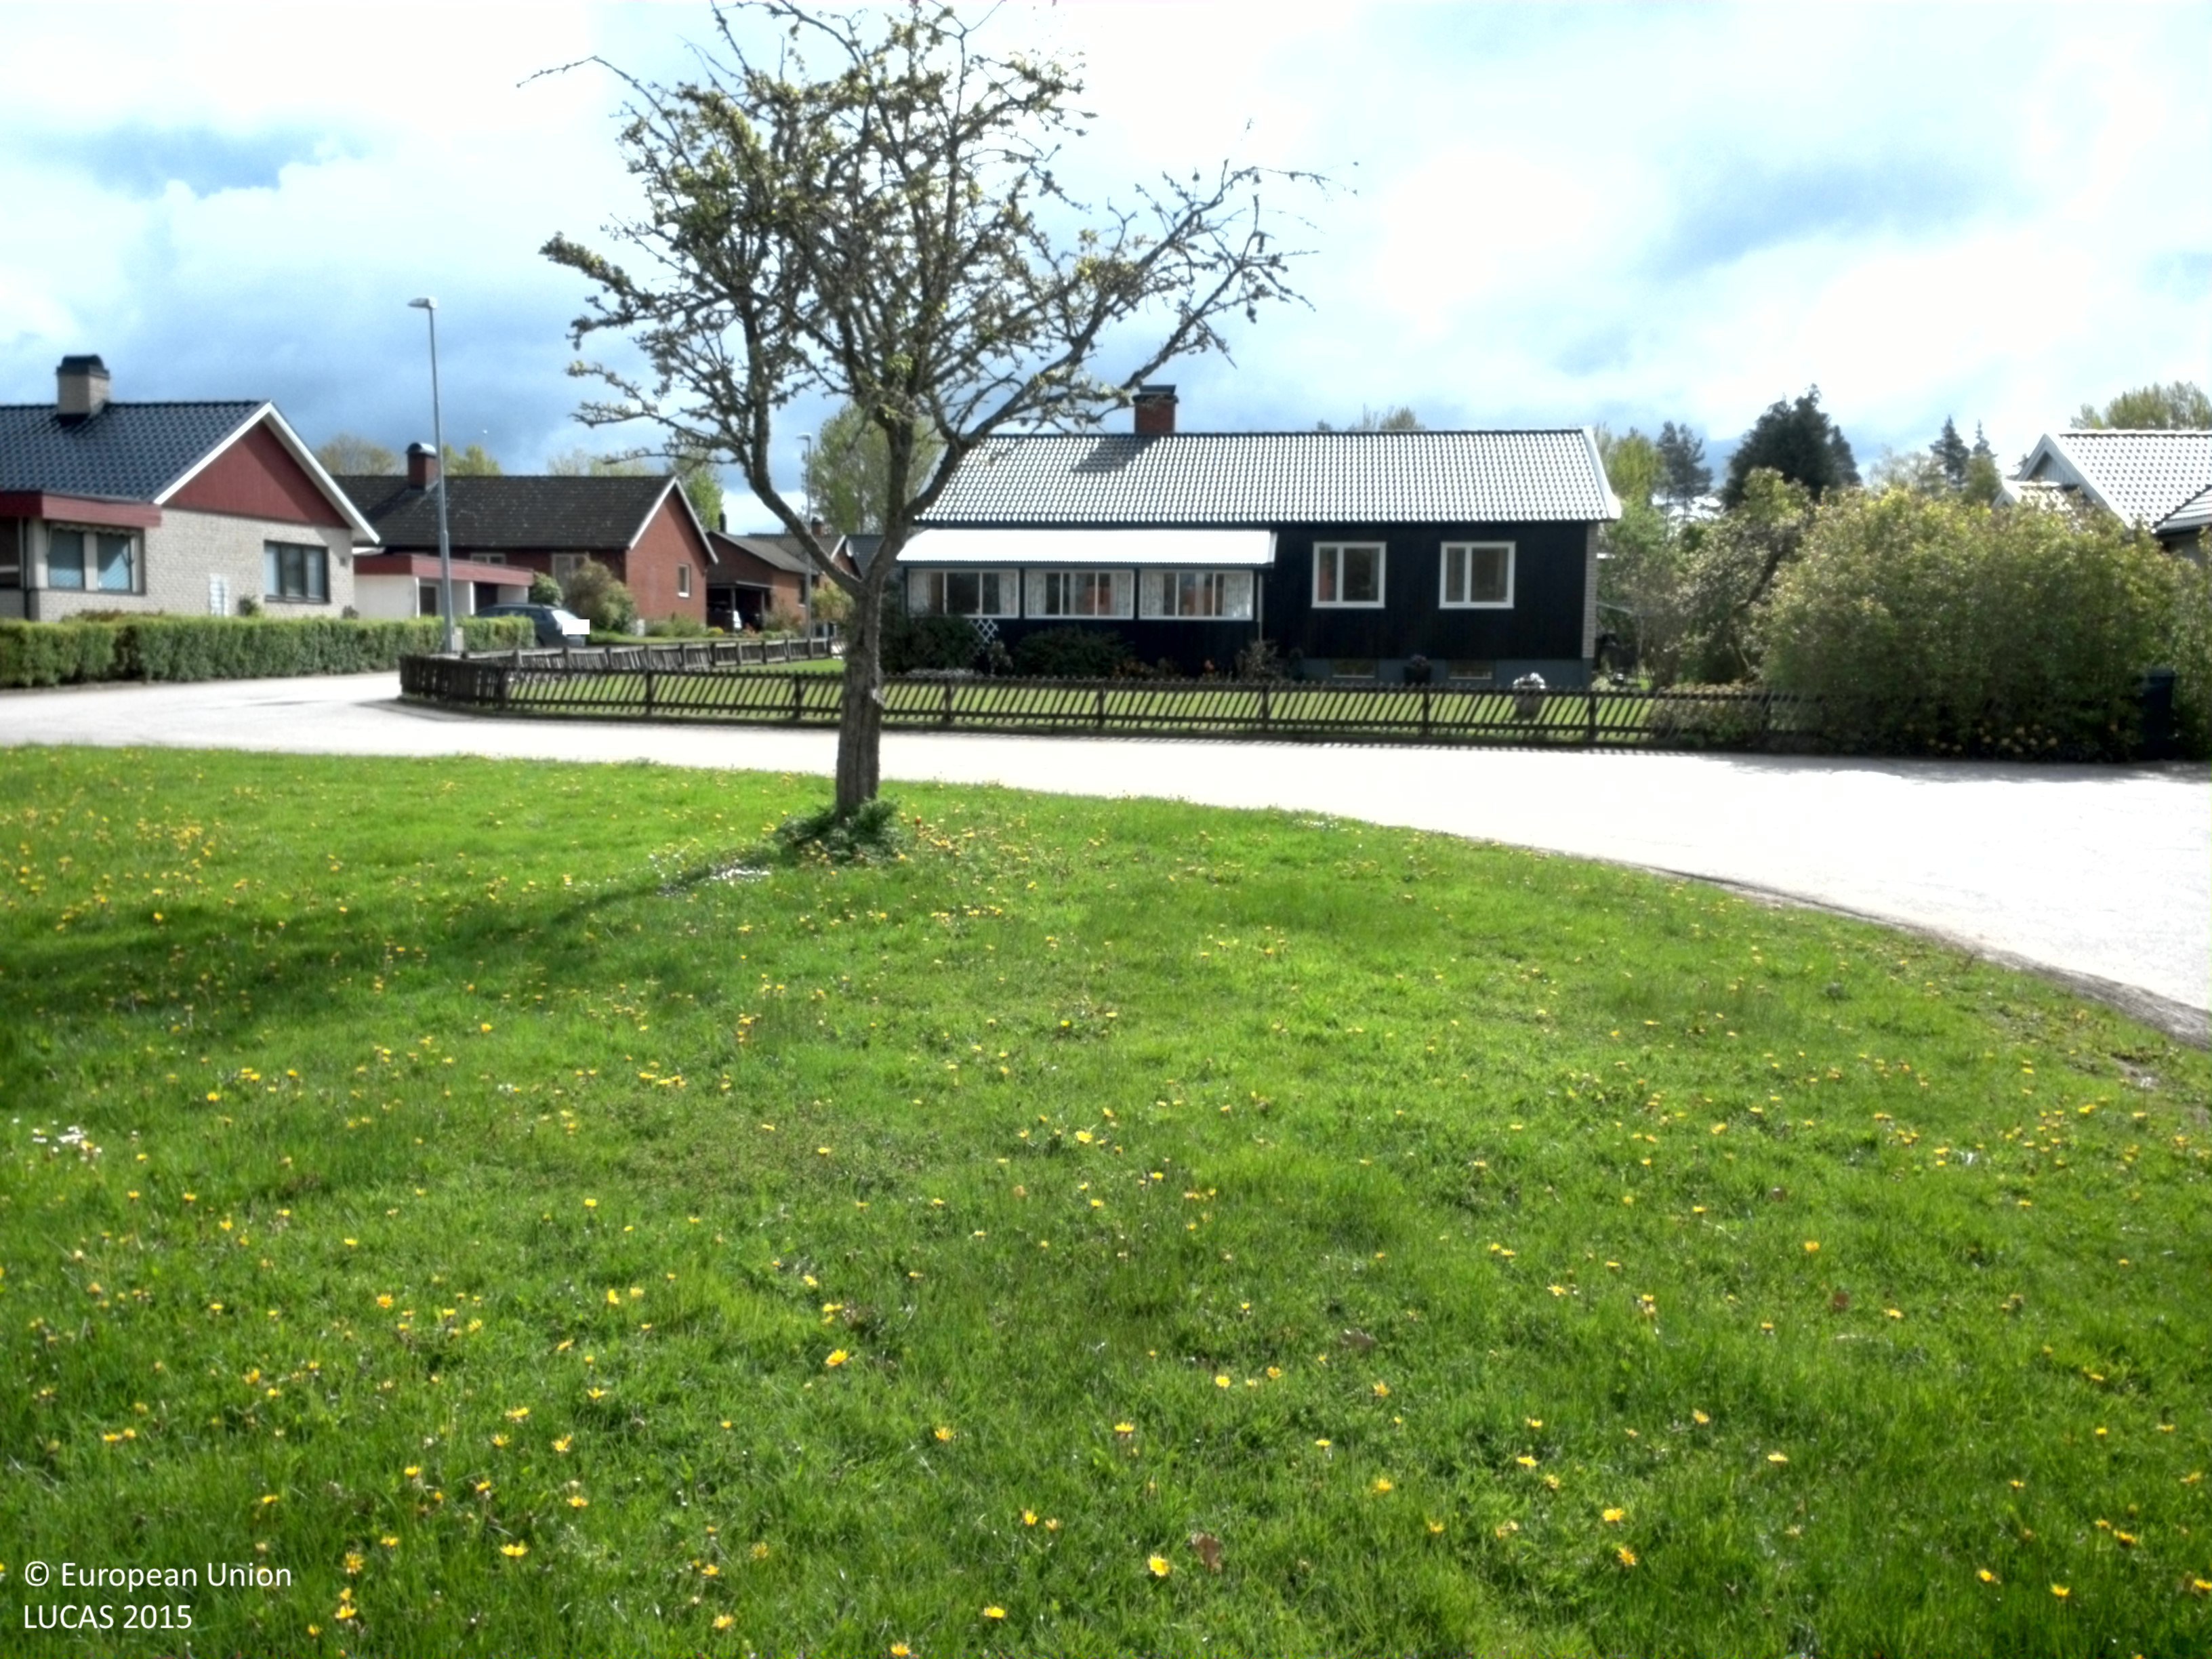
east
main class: Grassland
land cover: Grassland without tree/shrub cover
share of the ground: 50 - 75 %
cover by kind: herbaceous plants 50 %, consolidated bare surface 25 %
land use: Community services
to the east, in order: Grassland without tree/shrub cover; Artificial constructions in urban areas; Other mixed woodland; Ditches and canals; Paved roads, cycling and walking lanes; Ditches and canals; Shrubland with sparse tree cover; Tracks; Broadleaved woodland
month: May
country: SE
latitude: 56.8748
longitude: 14.7389
